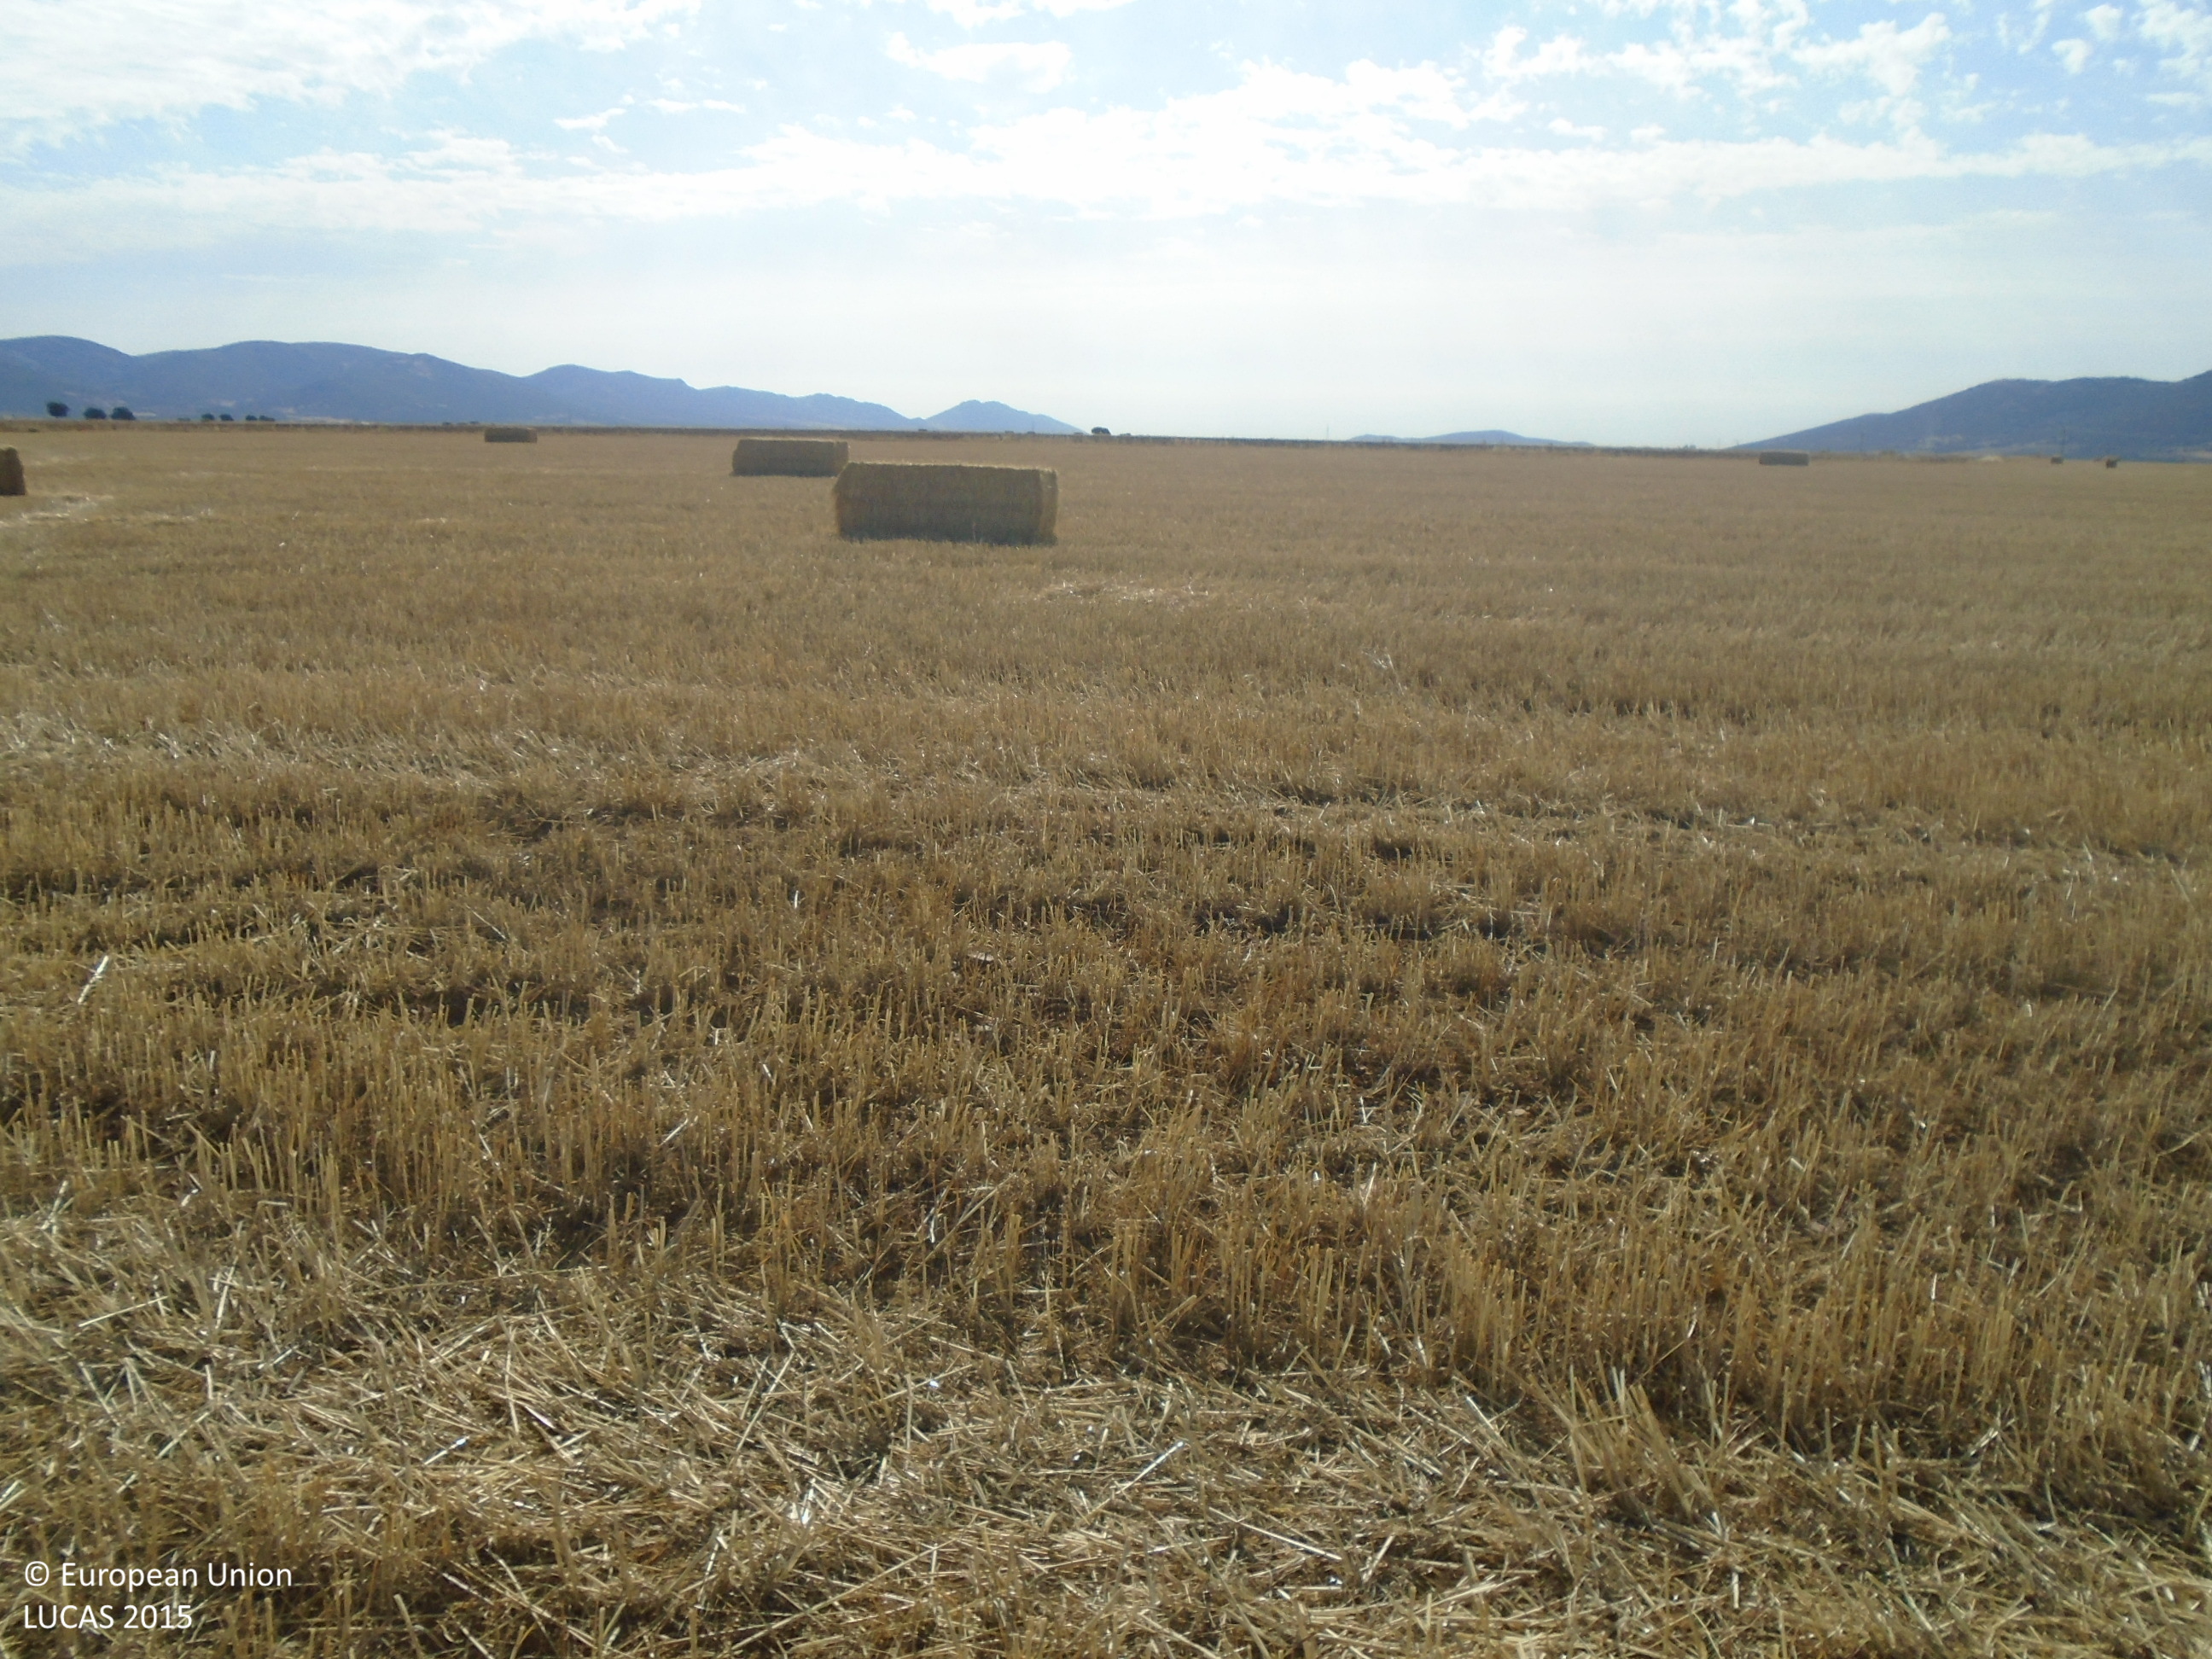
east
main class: Cropland
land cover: Common wheat
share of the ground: < 10 %
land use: Agriculture (excluding fallow land and kitchen gardens)
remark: Harvested field
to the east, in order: Common wheat; Grass margins; Other bare soil
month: July
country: ES
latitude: 39.1717
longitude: -4.0886
